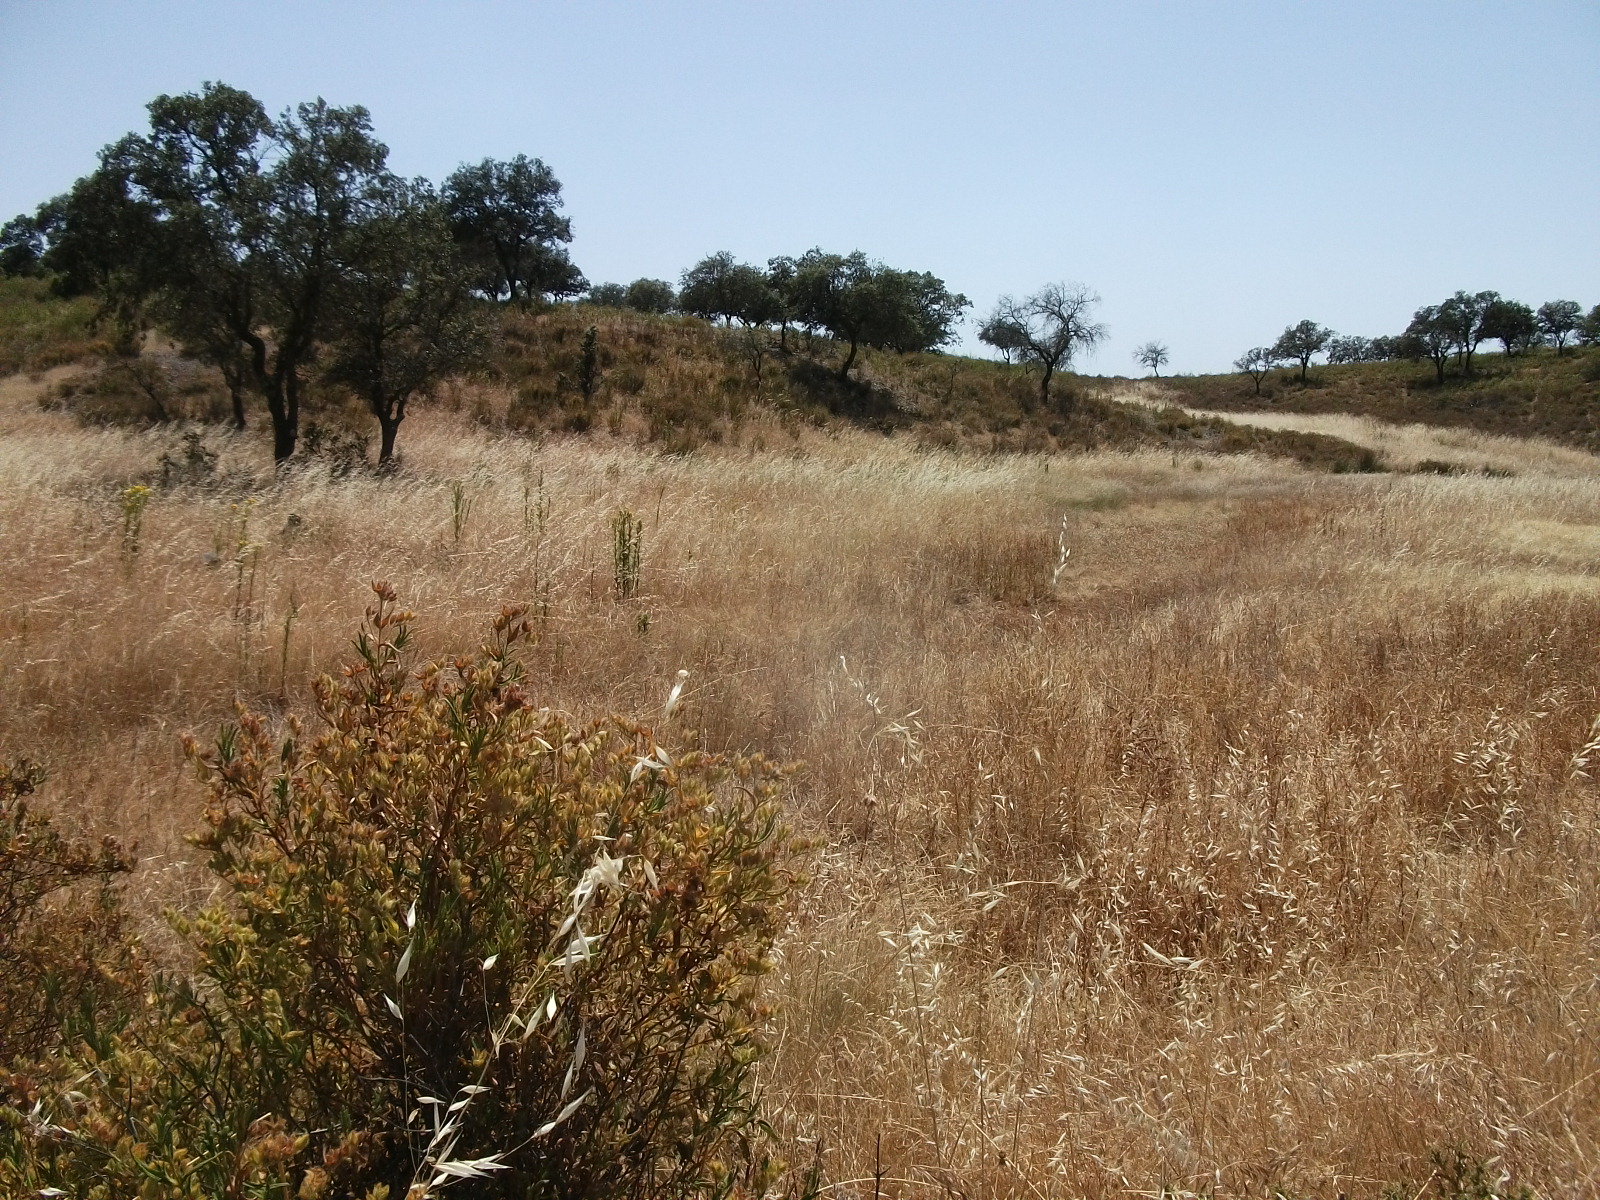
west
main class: Grassland
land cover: Grassland without tree/shrub cover
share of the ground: > 75 %
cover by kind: herbaceous plants 95 %, shrubs 5 %
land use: Agriculture (excluding fallow land and kitchen gardens)
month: June
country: ES
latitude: 37.5237
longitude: -6.9599
